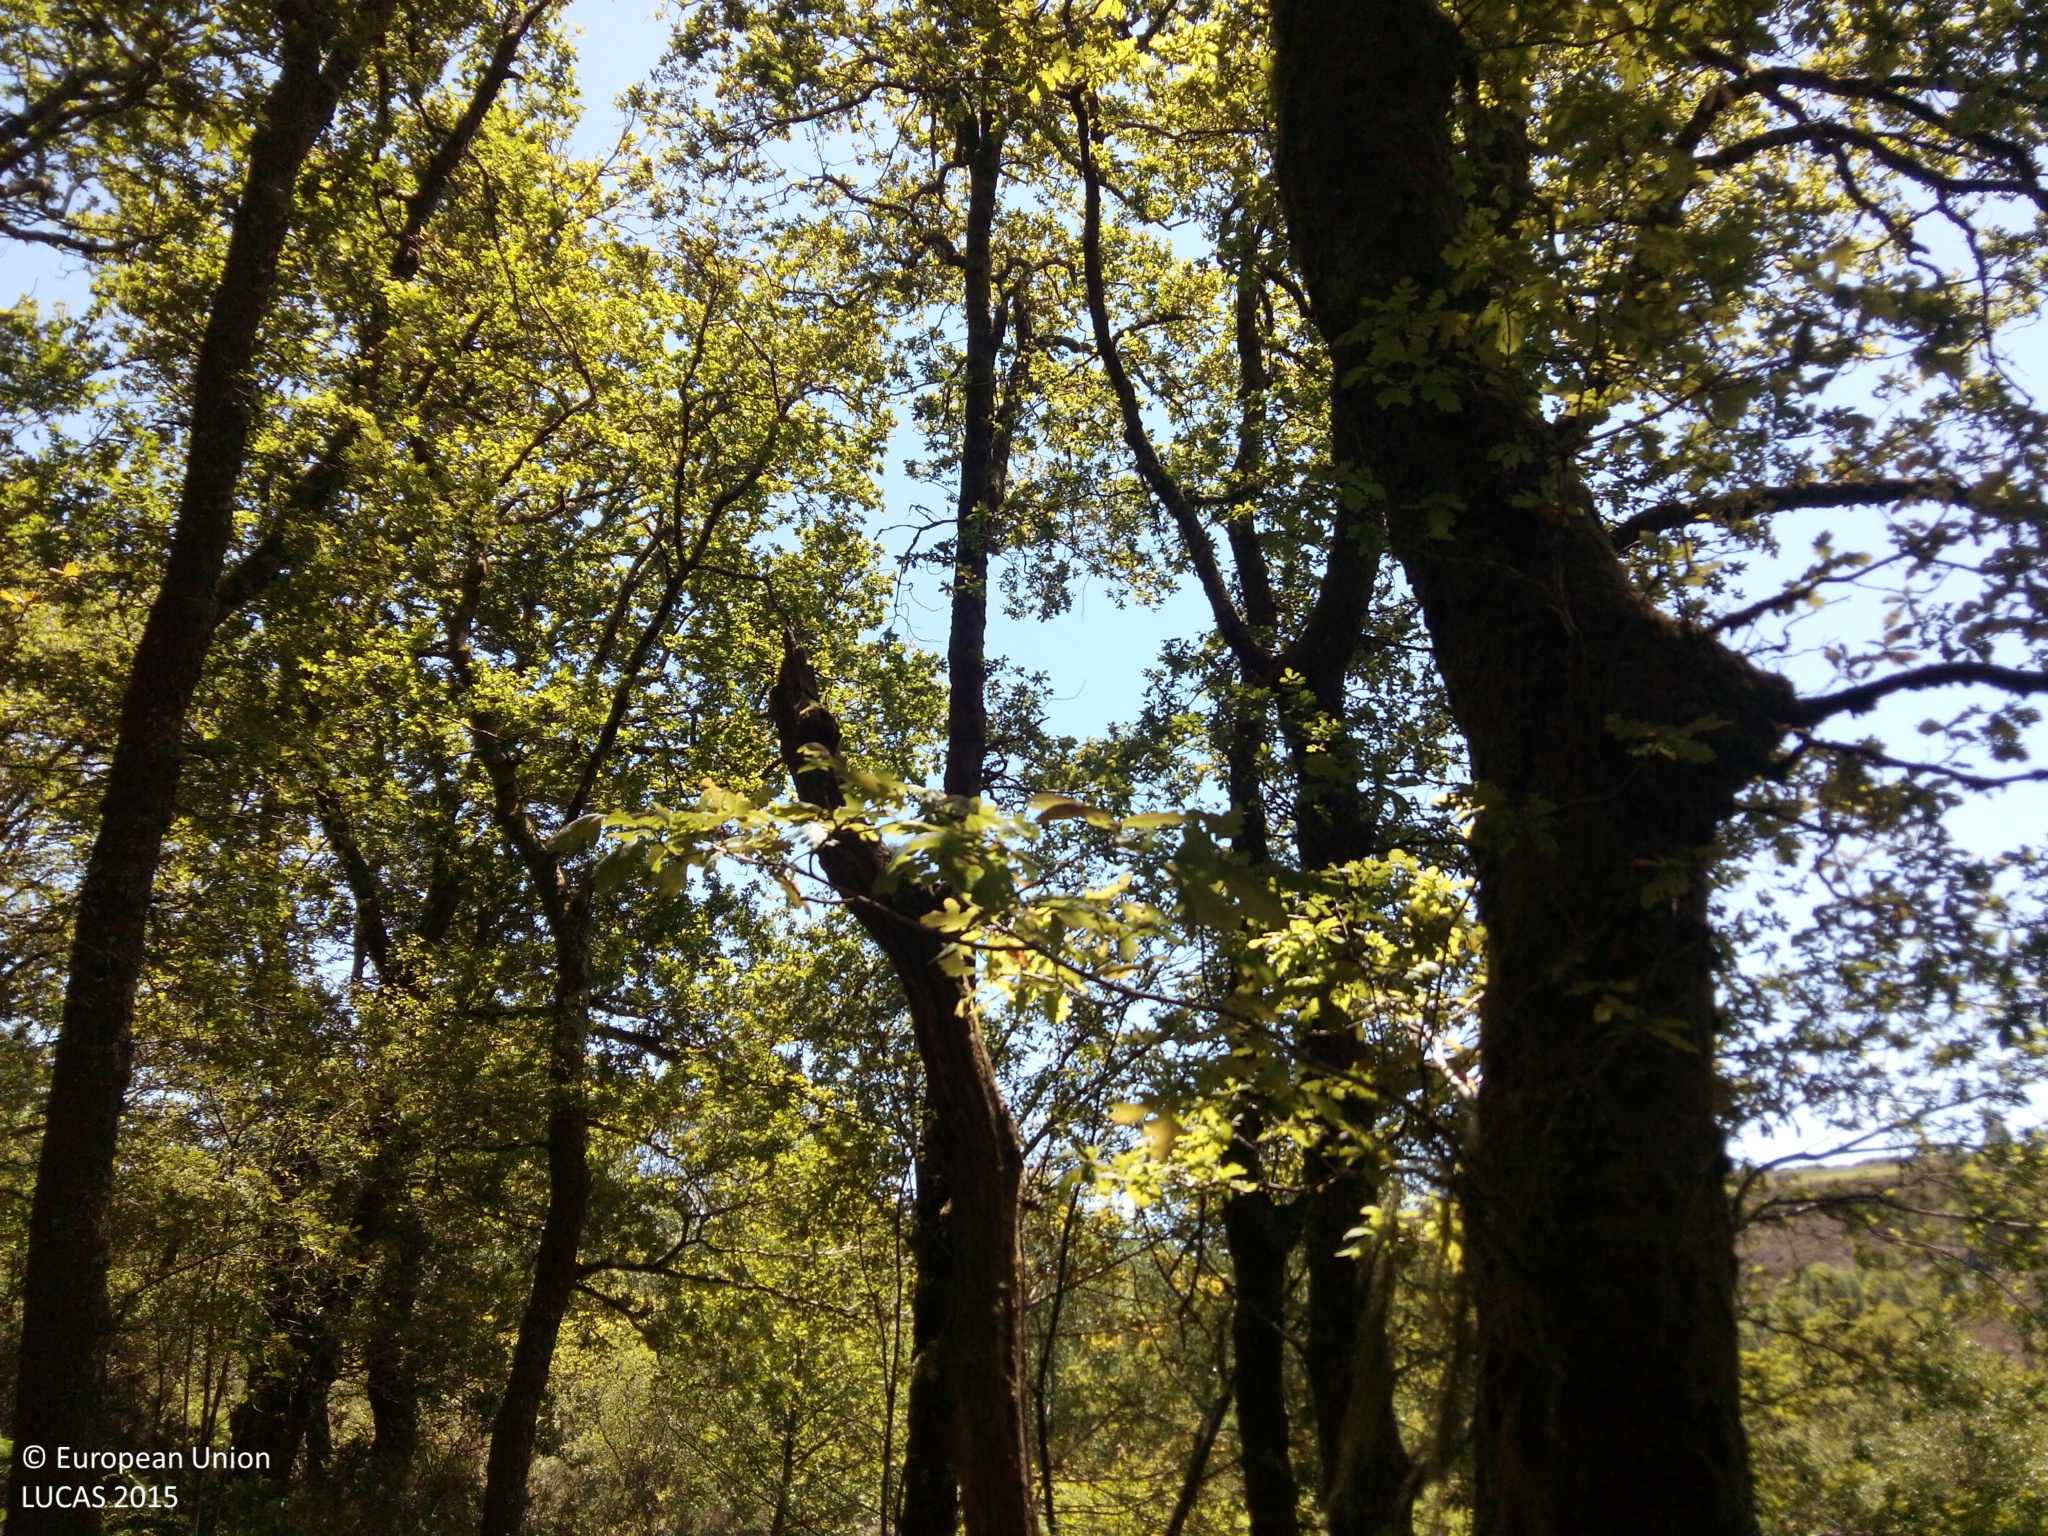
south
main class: Woodland
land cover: Broadleaved woodland
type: acidophilous oak and oak-birch forest
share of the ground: > 75 %
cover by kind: broadleaved forest trees 100 %
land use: Forestry
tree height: > 5 m
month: May
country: ES
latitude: 42.6015
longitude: -8.3657
